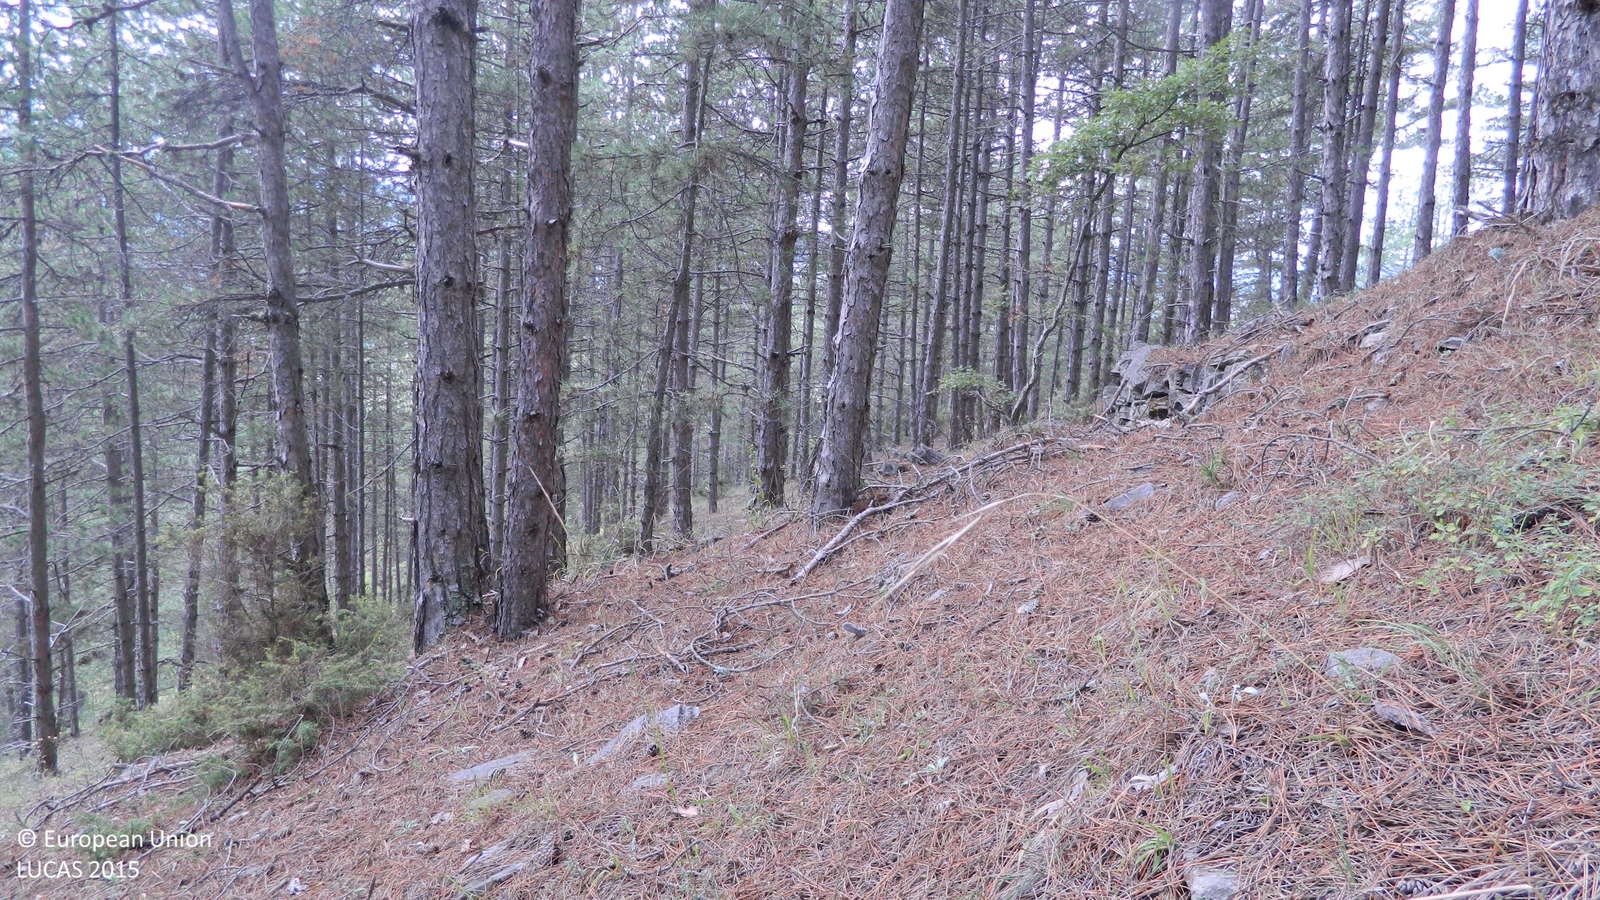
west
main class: Woodland
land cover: Pine dominated coniferous woodland
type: hemiboreal forest and nemoral coniferous forest and mixed broadleaved-coniferous forest
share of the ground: > 75 %
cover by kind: coniferous forest trees 80 %, unconsolidated bare surface 20 %
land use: Forestry
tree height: > 5 m
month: September
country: BG
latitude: 41.4885
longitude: 24.0333
